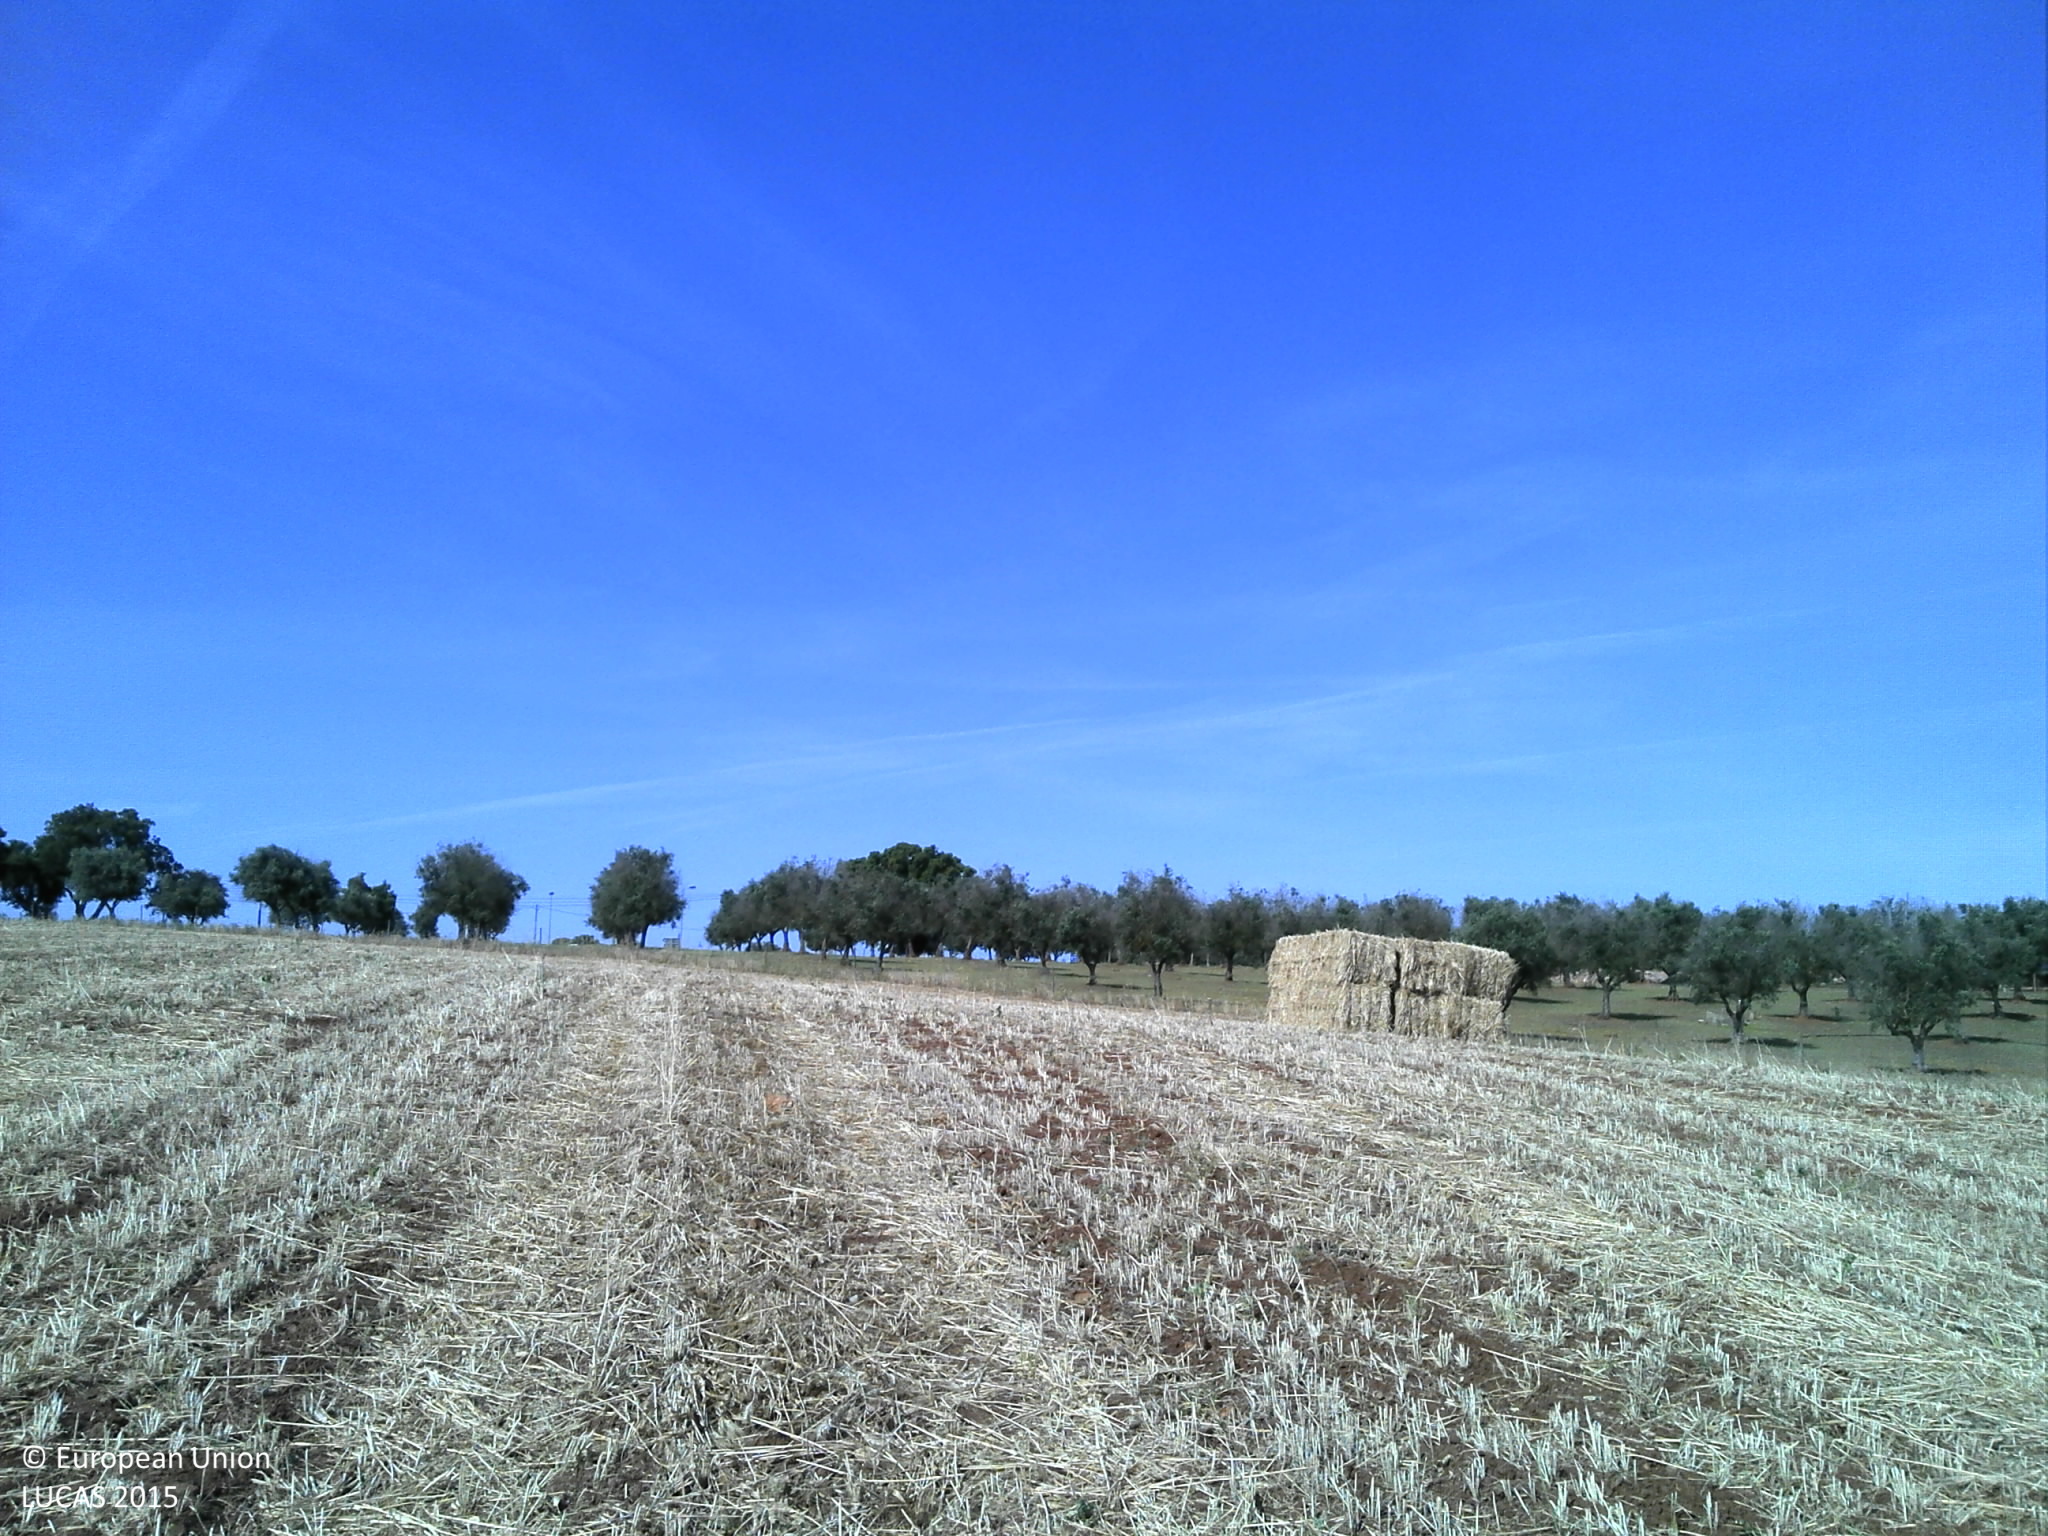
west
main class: Cropland
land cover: Triticale
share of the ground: < 10 %
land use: Agriculture (excluding fallow land and kitchen gardens)
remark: Harvested field
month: May
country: PT
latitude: 39.0429
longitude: -7.6381
